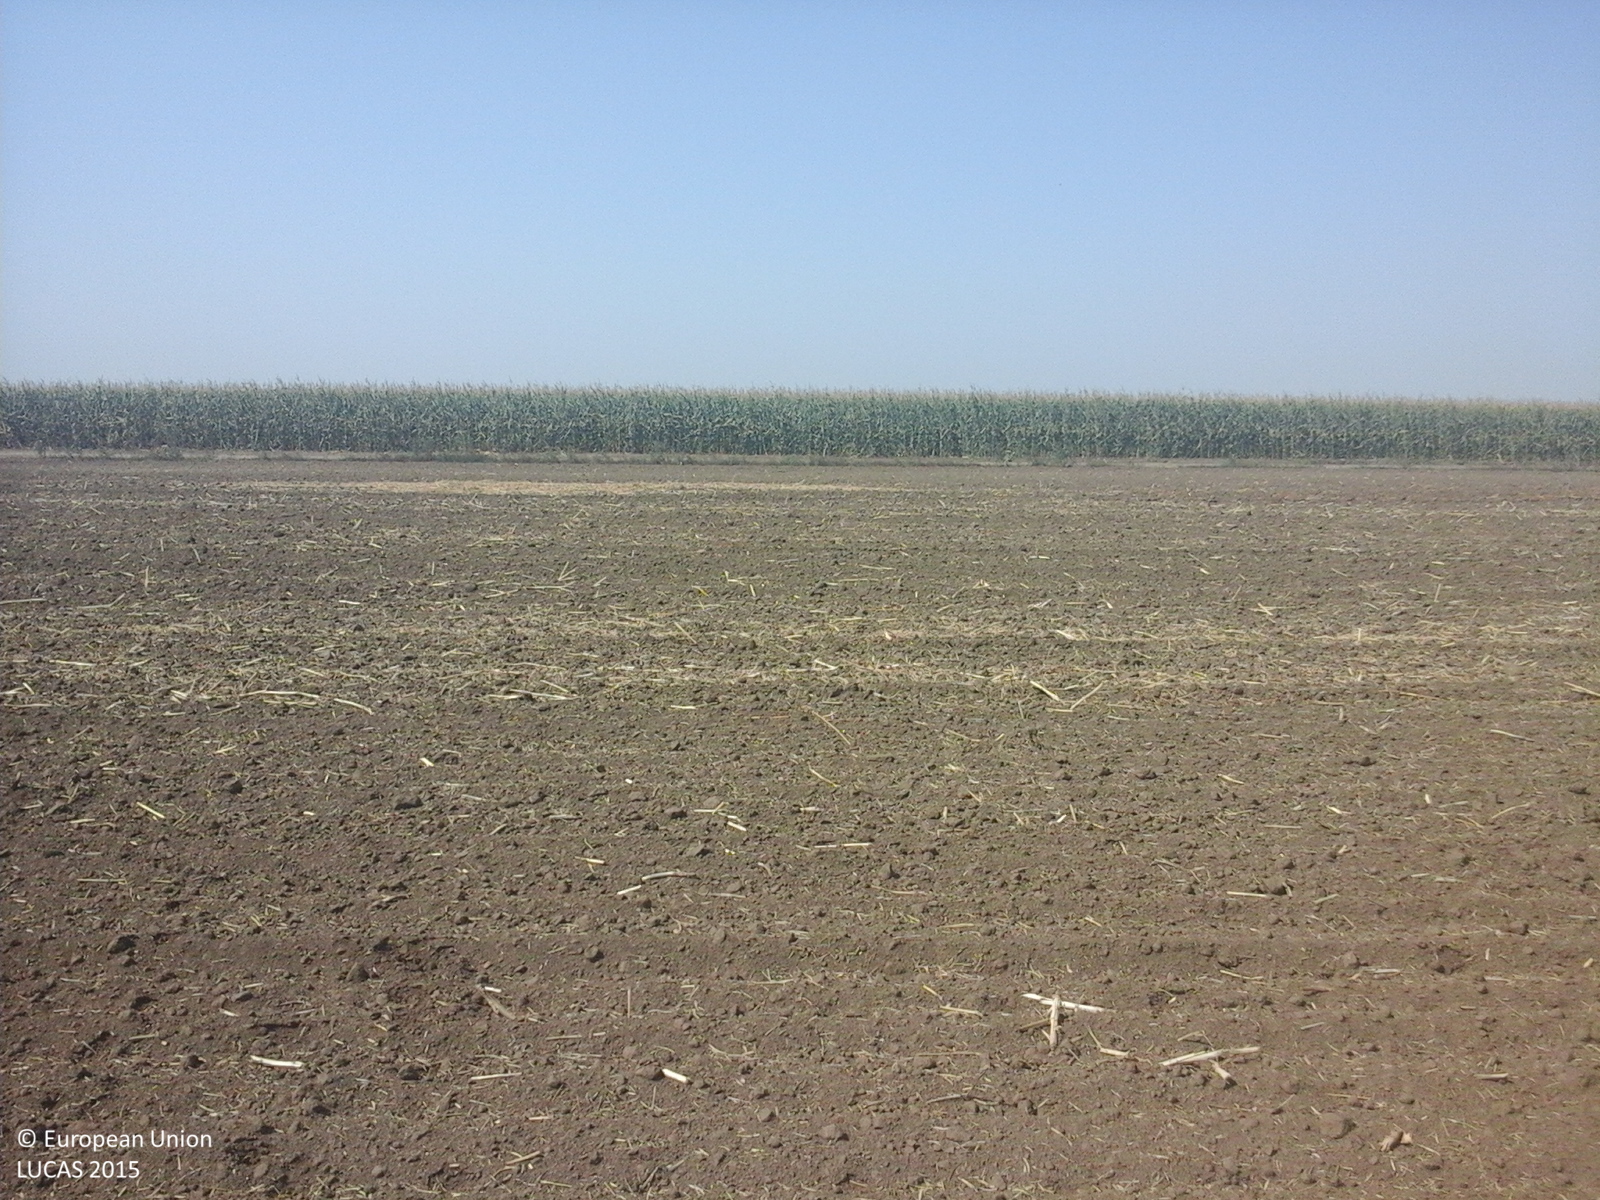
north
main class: Cropland
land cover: Maize
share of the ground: > 75 %
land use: Agriculture (excluding fallow land and kitchen gardens)
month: July
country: RO
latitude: 44.7102
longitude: 27.6051
